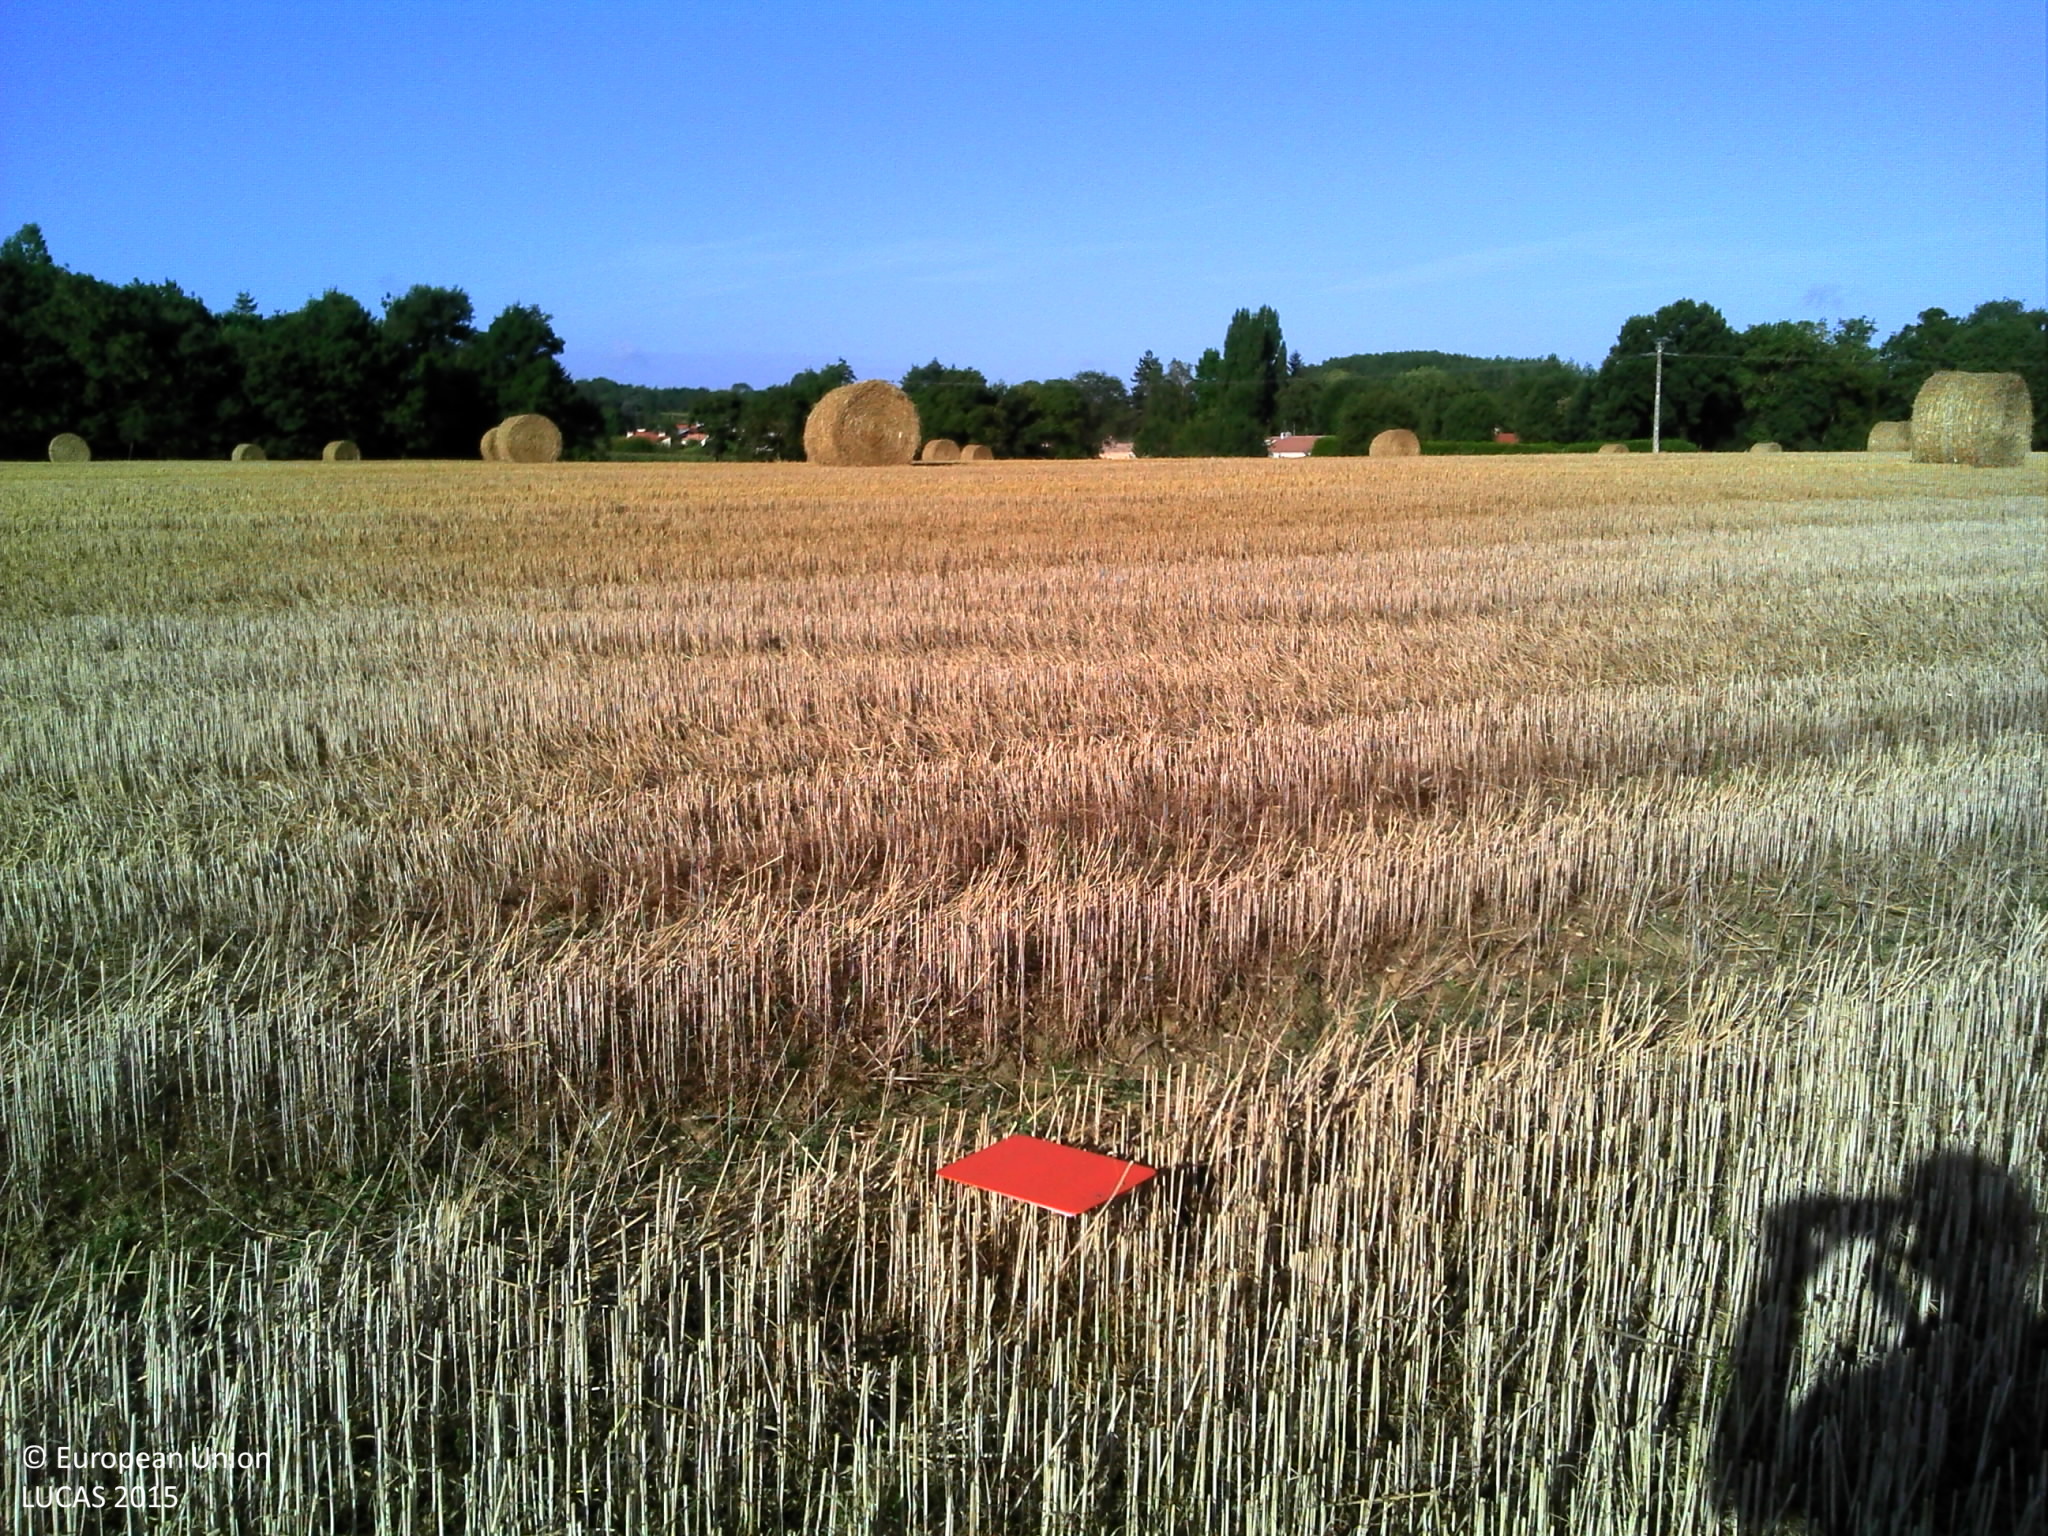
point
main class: Cropland
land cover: Triticale
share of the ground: > 75 %
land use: Agriculture (excluding fallow land and kitchen gardens)
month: August
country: FR
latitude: 47.0384
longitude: -1.6634
